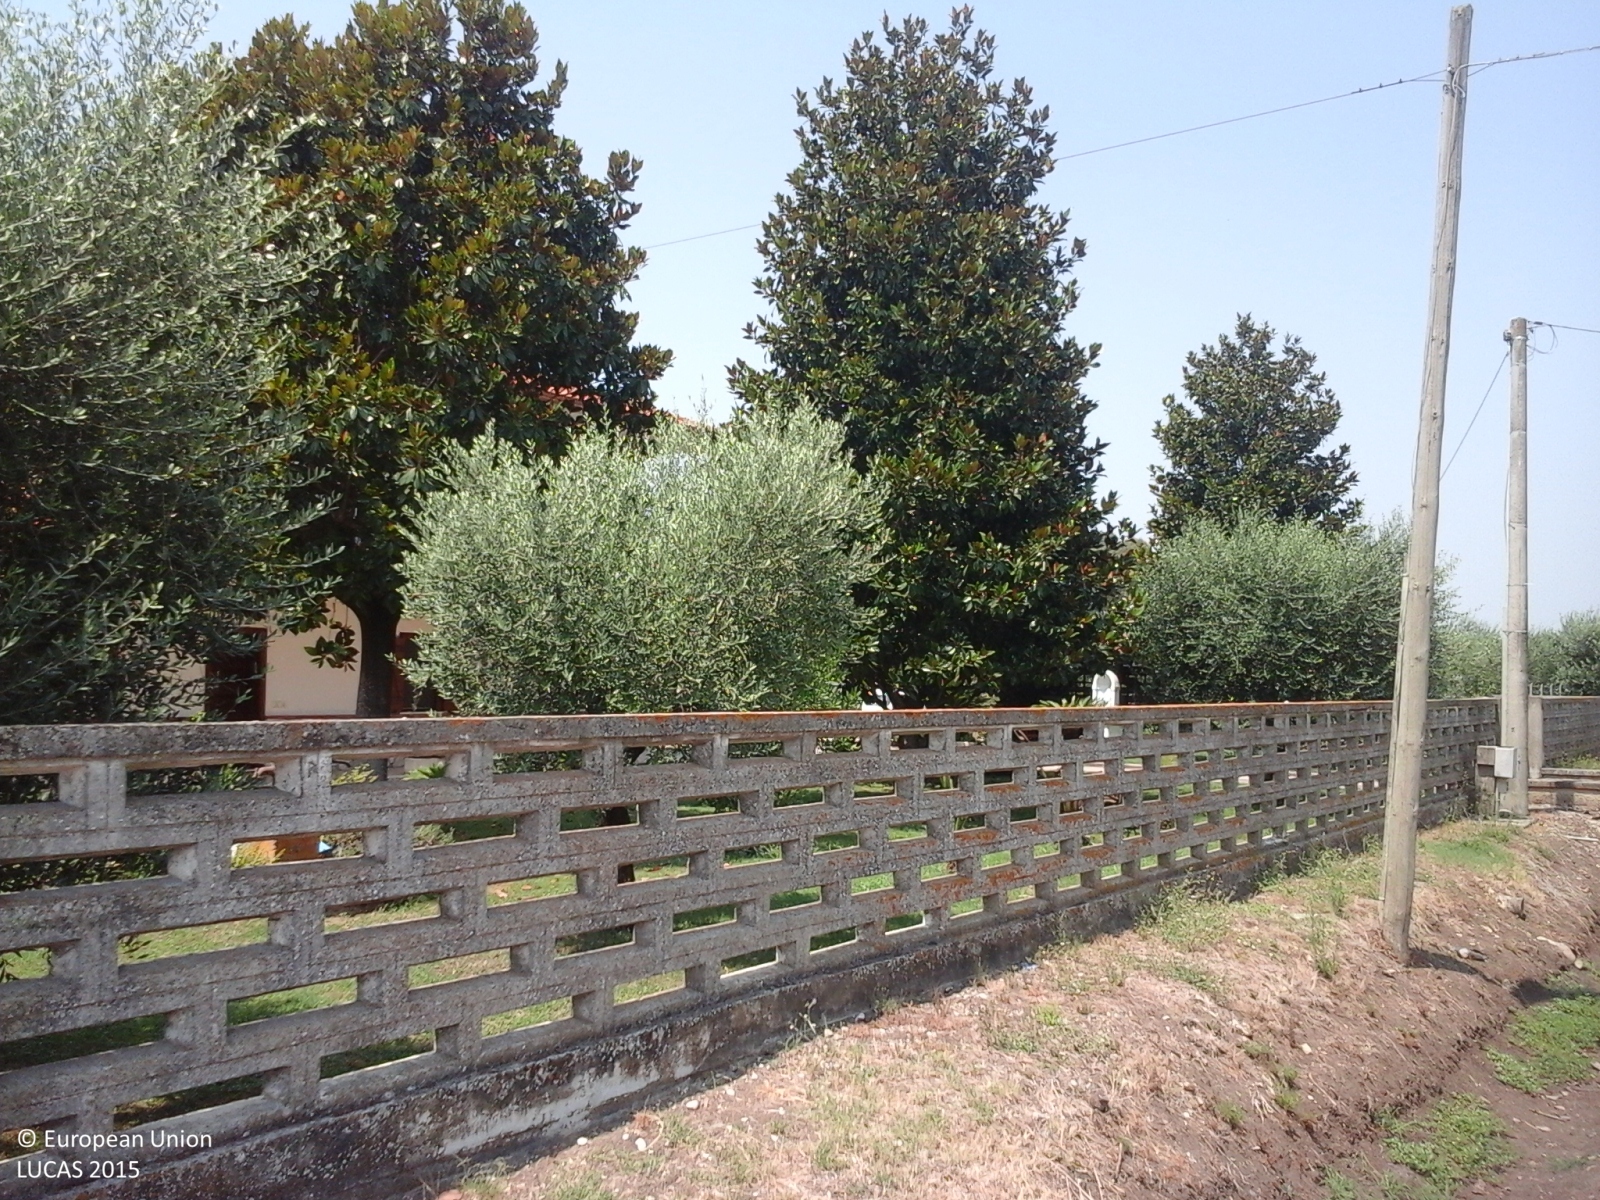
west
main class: Cropland
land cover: Olive groves
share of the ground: > 75 %
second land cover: Grassland without tree/shrub cover
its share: > 75 %
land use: Kitchen garden
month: July
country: IT
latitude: 41.4714
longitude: 12.9697
